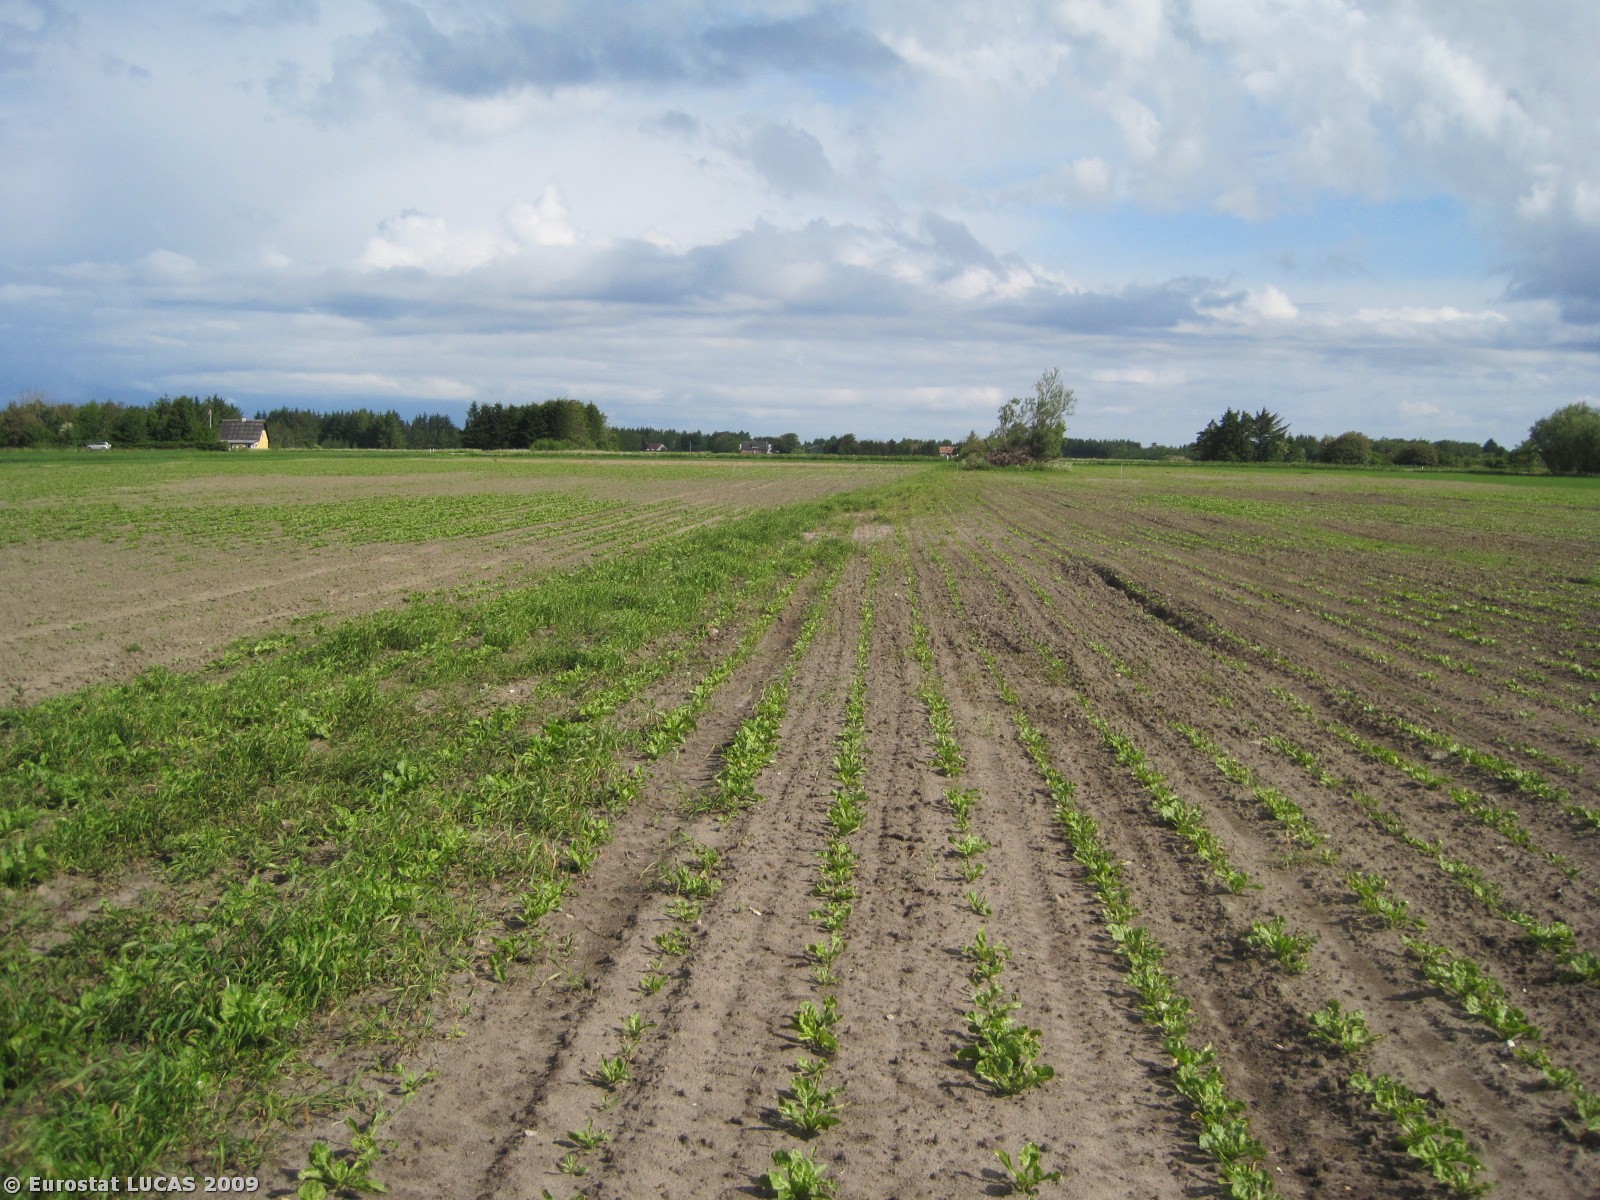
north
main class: Cropland
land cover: Sugar beet
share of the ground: 10 - 25 %
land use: Agriculture (excluding fallow land and kitchen gardens)
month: June
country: DK
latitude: 57.5720
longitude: 10.1502
